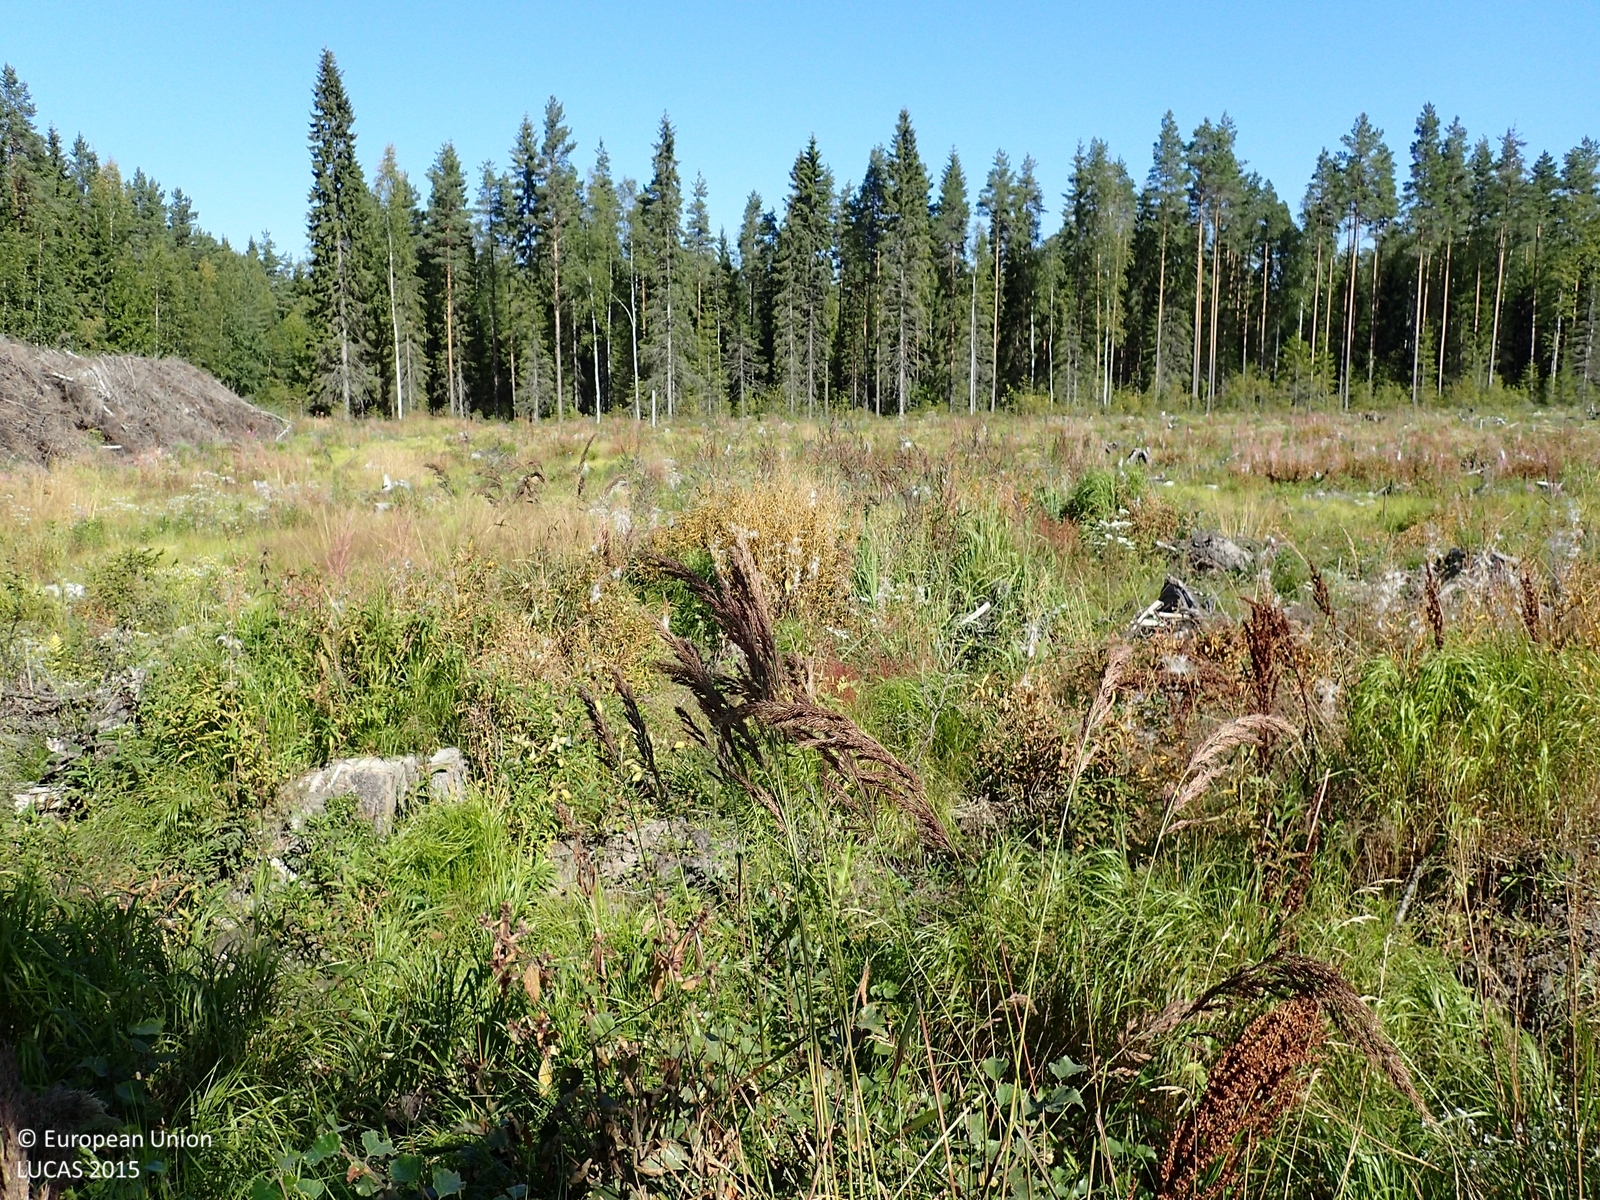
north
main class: Grassland
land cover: Grassland with sparse tree/shrub cover
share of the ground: > 75 %
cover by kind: herbaceous plants 95 %, broadleaved forest trees 5 %
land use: Forestry
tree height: < 5 m
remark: Clear cut
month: August
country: FI
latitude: 62.4267
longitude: 21.7236
